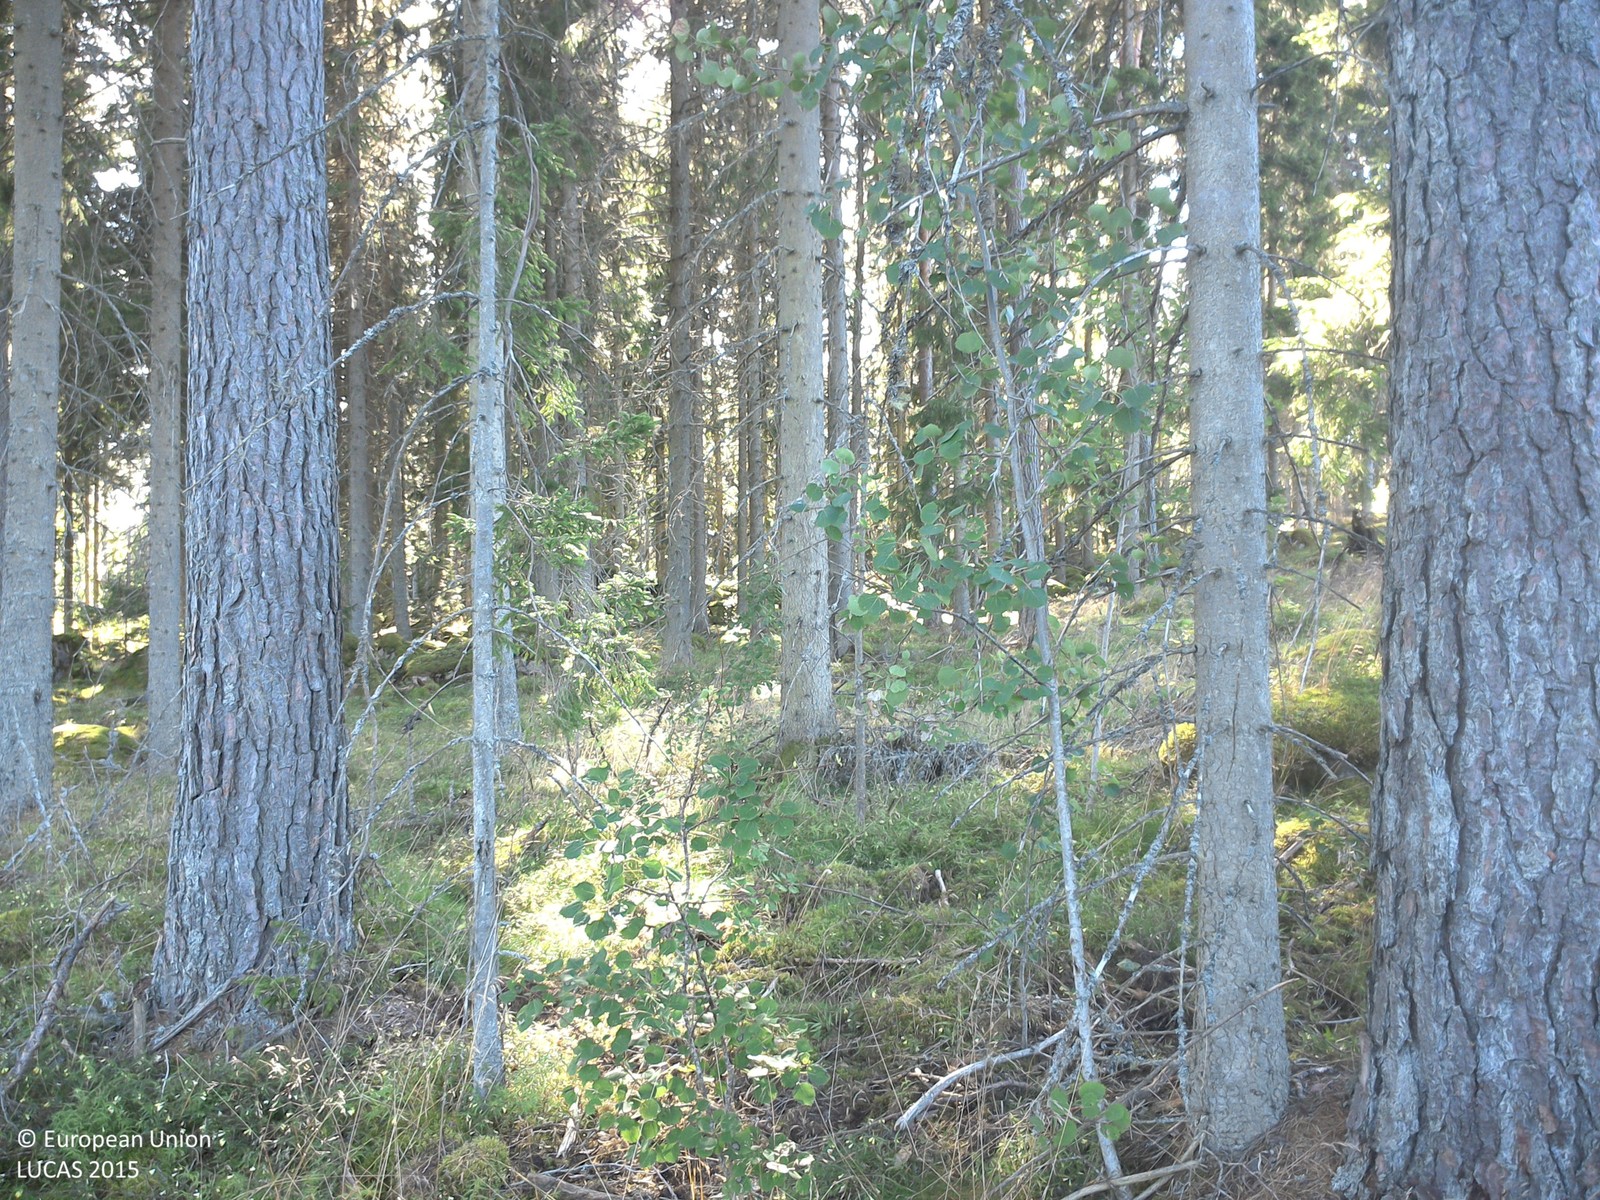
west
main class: Woodland
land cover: Spruce dominated coniferous woodland
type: boreal forest
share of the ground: 50 - 75 %
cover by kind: coniferous forest trees 55 %, lichens and mosses 45 %
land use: Forestry
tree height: > 5 m
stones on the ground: < 10 %
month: August
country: SE
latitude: 58.2236
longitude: 15.2896
